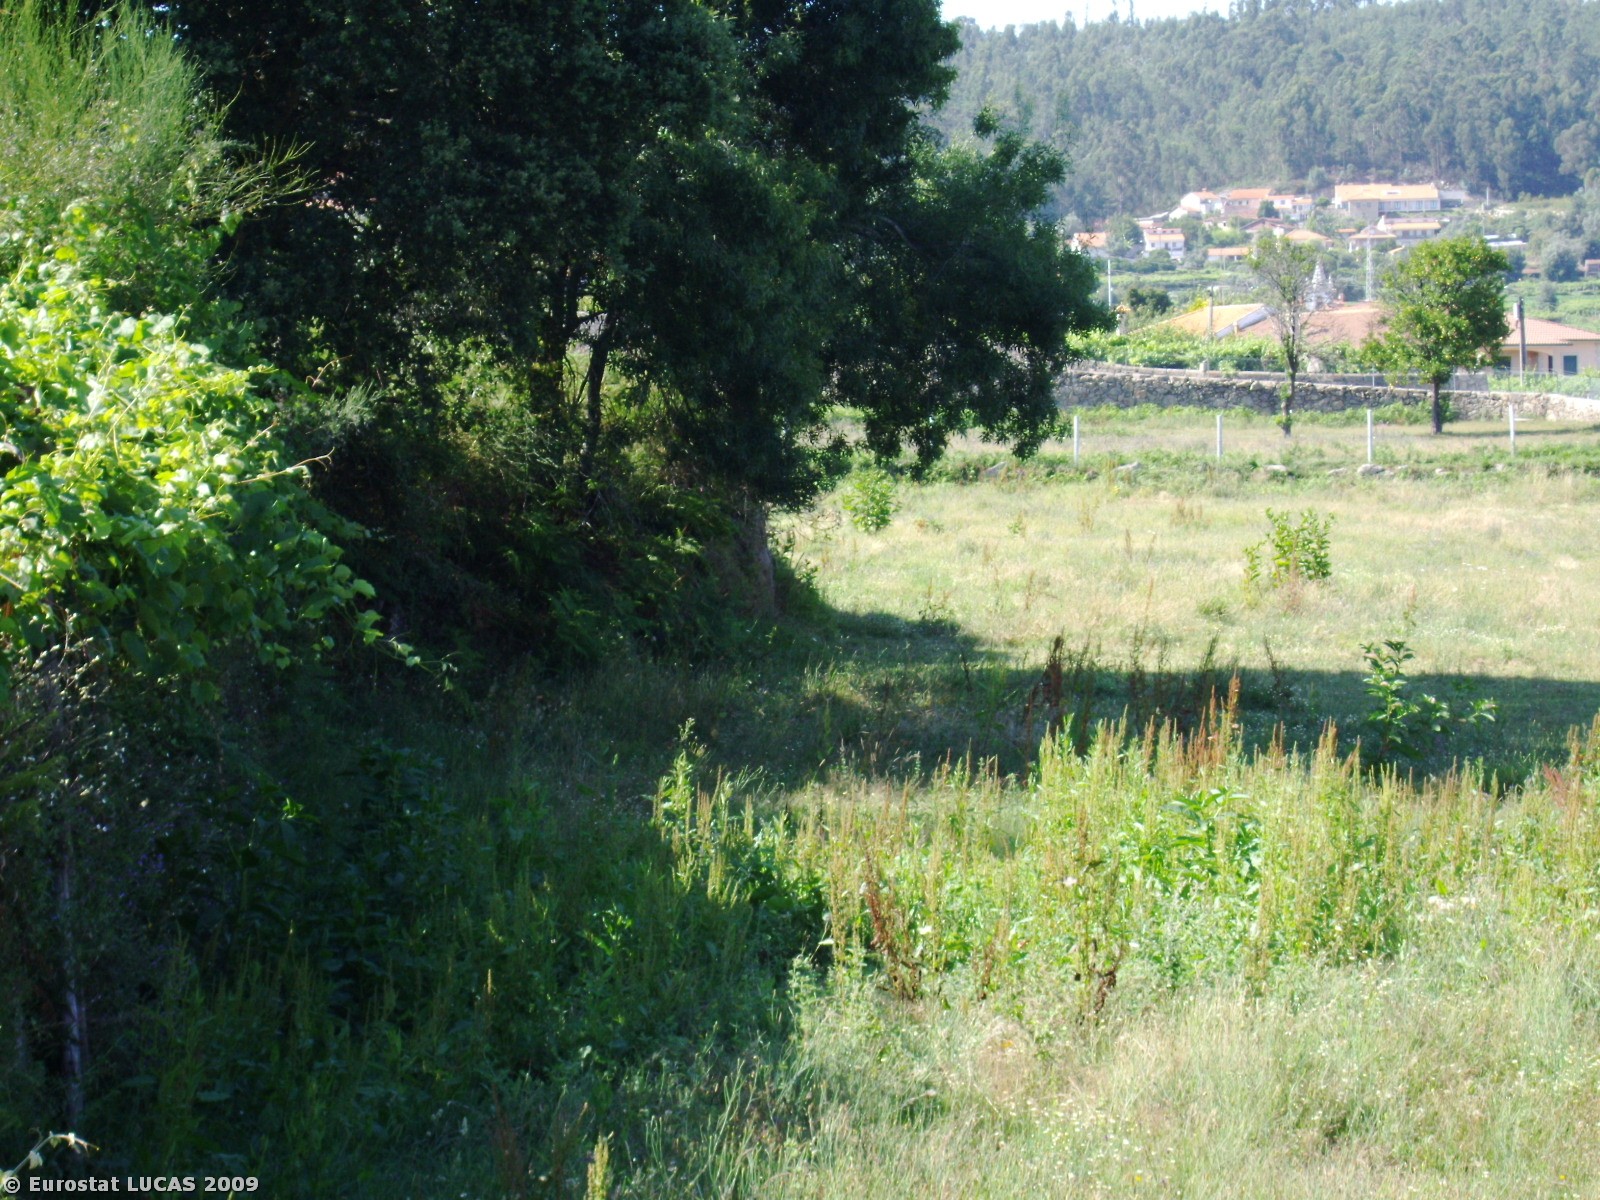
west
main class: Woodland
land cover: Broadleaved woodland
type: acidophilous oak and oak-birch forest
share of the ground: 50 - 75 %
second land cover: Spontaneously vegetated surfaces
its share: 25 - 50 %
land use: Agriculture (excluding fallow land and kitchen gardens)
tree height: > 5 m
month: July
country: PT
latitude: 41.5530
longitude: -8.7346
